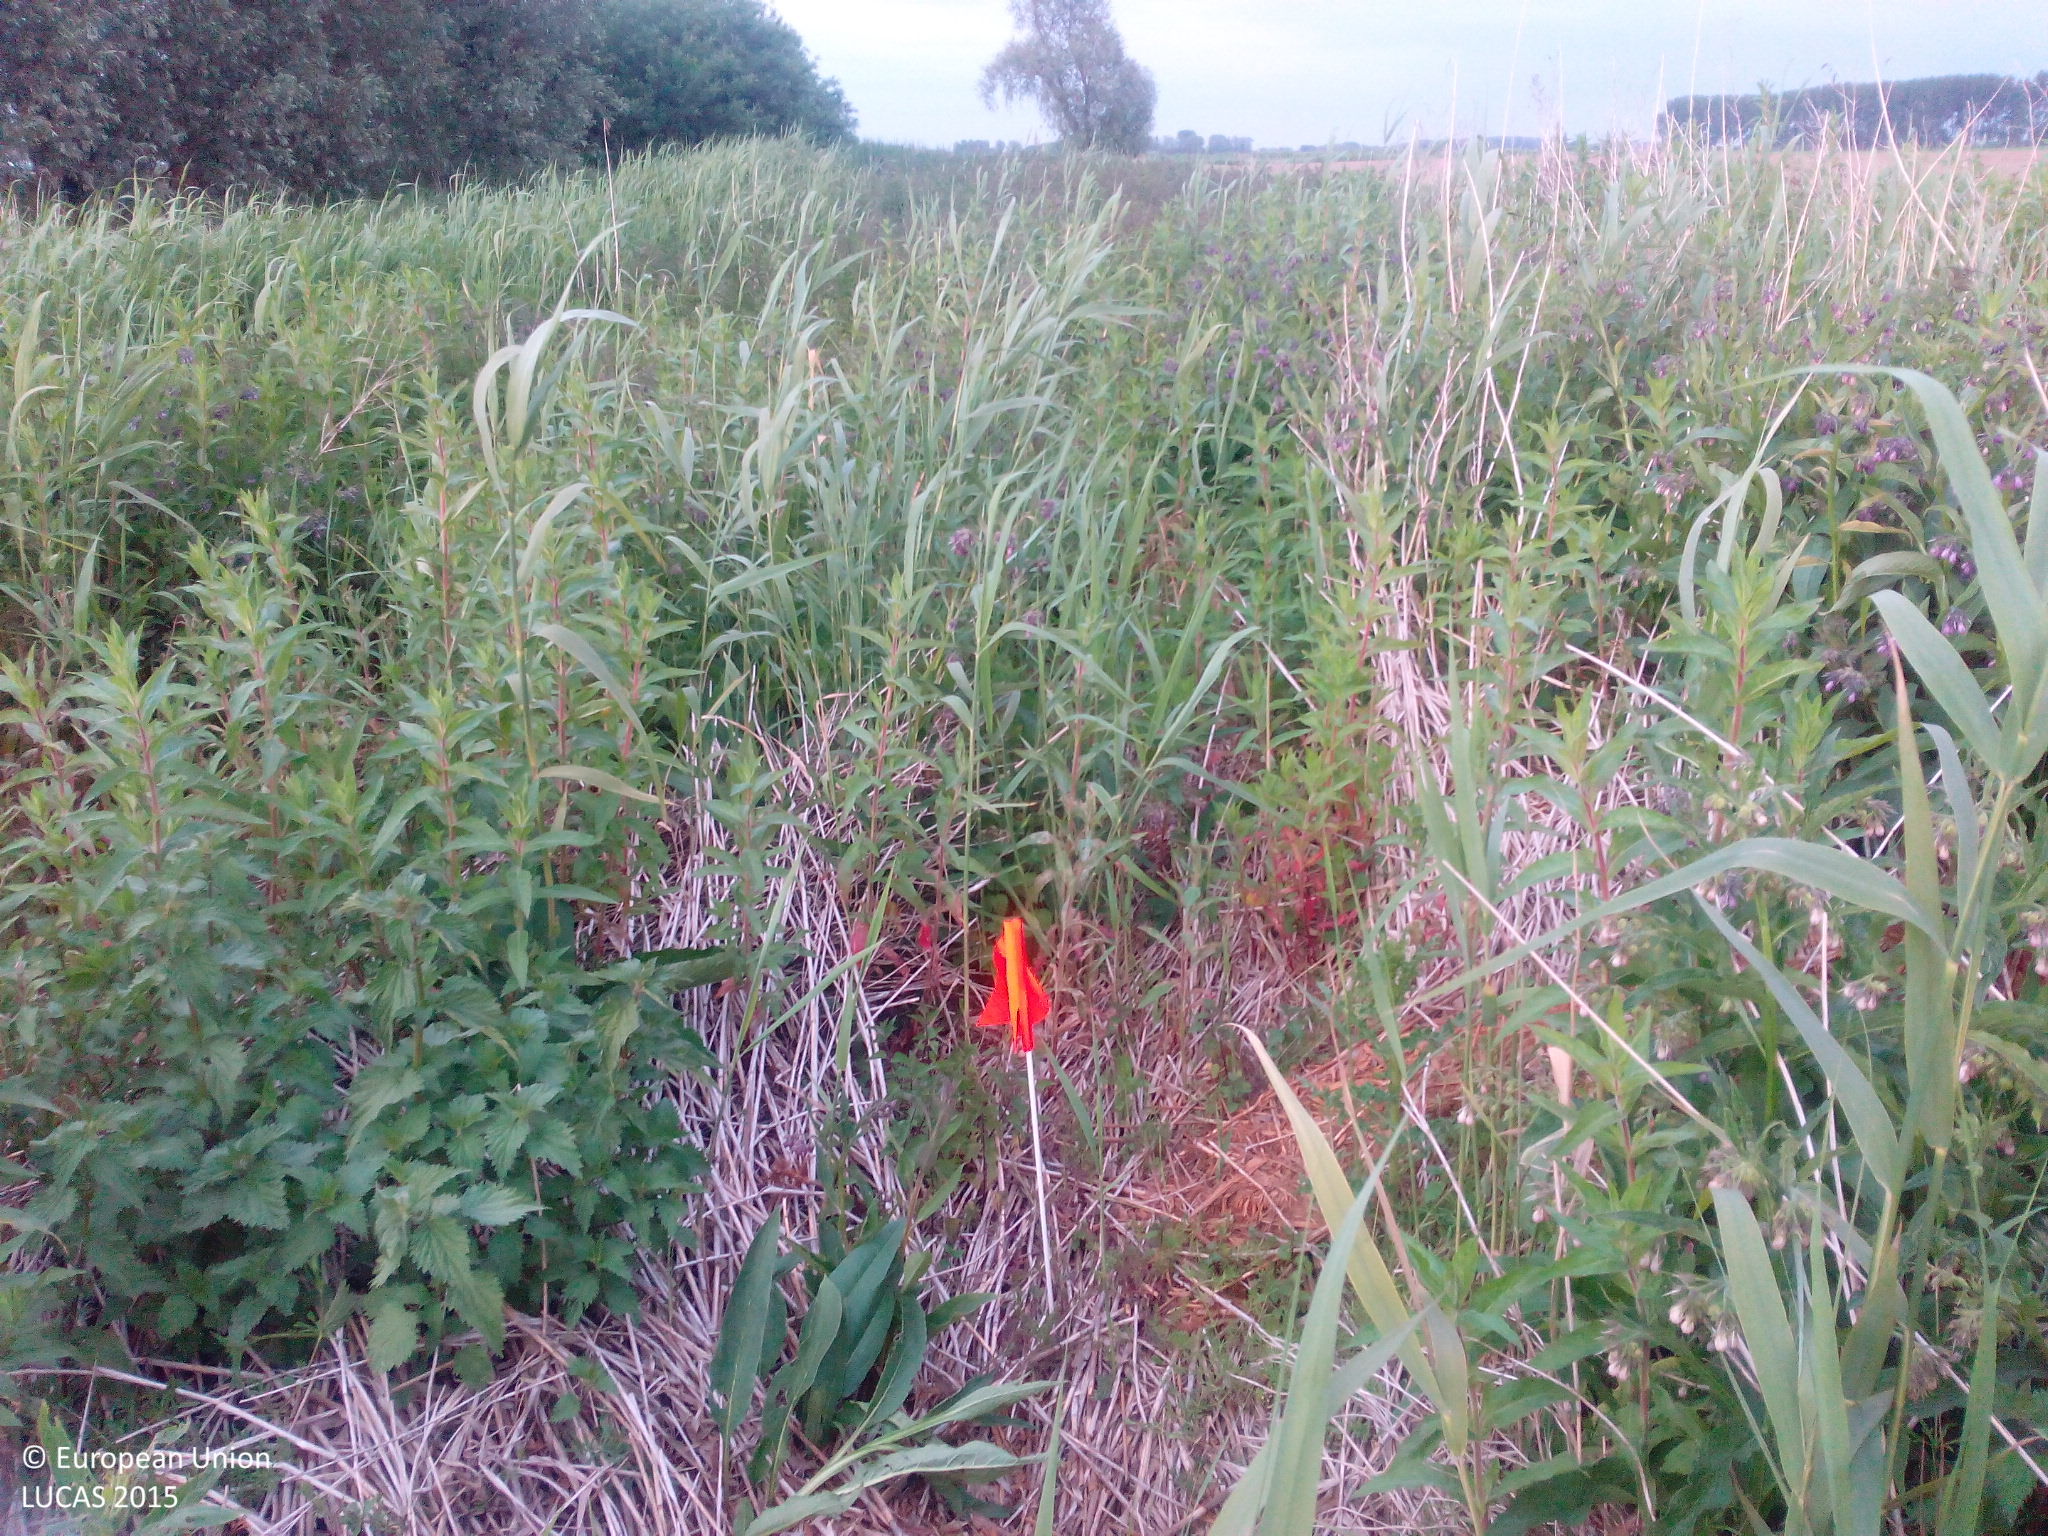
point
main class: Grassland
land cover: Spontaneously vegetated surfaces
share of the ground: 50 - 75 %
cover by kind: herbaceous plants 100 %
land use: Semi-natural and natural areas not in use
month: May
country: NL
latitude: 51.2950
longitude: 4.1291
